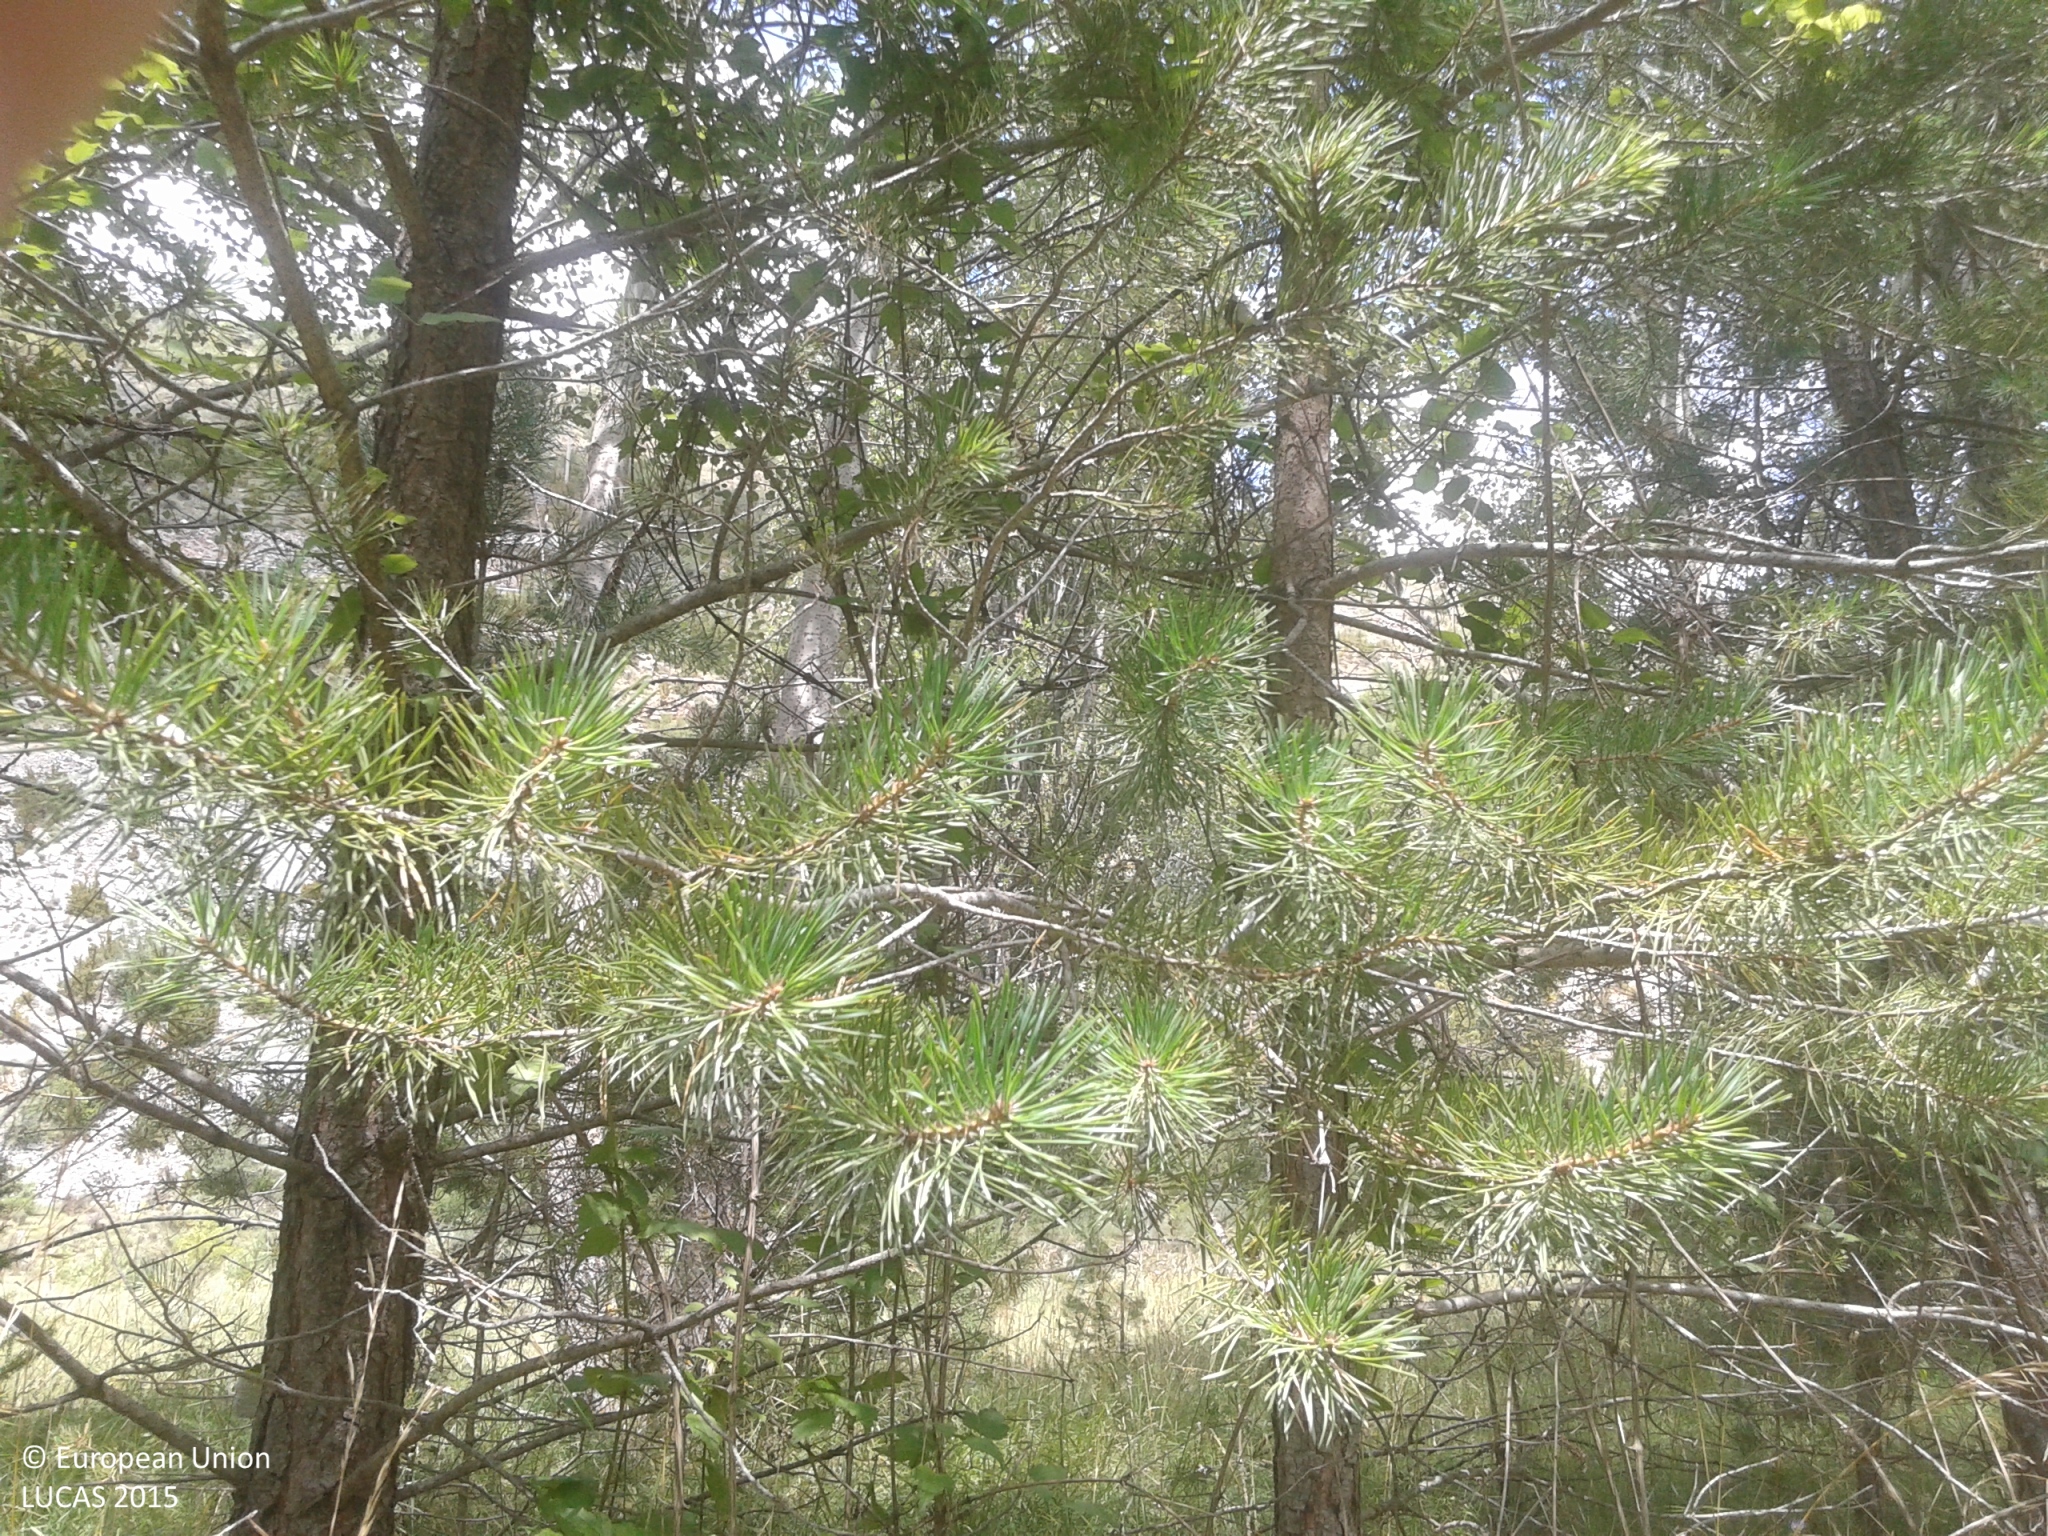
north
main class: Woodland
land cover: Other mixed woodland
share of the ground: > 75 %
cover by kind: broadleaved forest trees 65 %, coniferous forest trees 25 %, shrubs 5 %, herbaceous plants 5 %
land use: Semi-natural and natural areas not in use
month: July
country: ES
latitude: 42.2511
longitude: 1.6117
